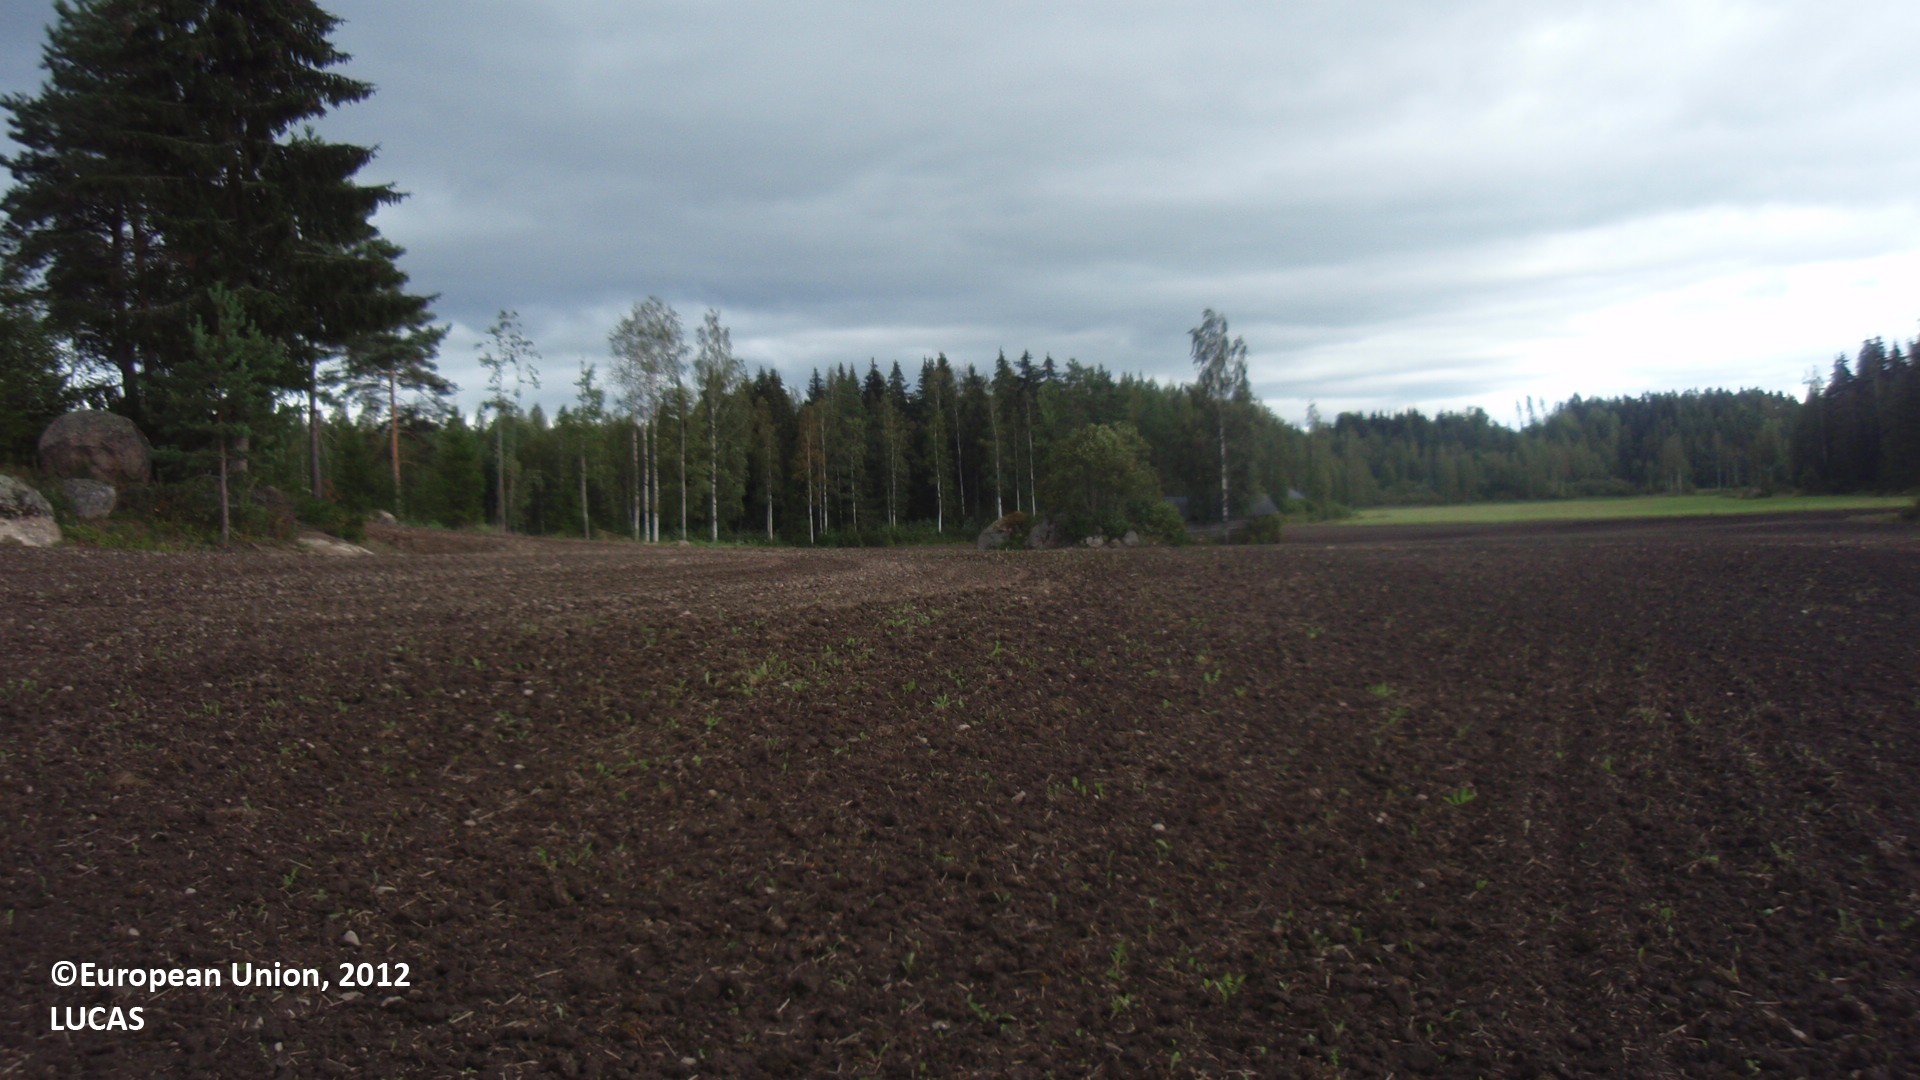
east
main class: Cropland
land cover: Oats
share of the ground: > 75 %
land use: Agriculture (excluding fallow land and kitchen gardens)
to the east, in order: Oats; Ditches and canals; Spruce dominated mixed woodland
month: August
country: FI
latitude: 61.0115
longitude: 27.0946
